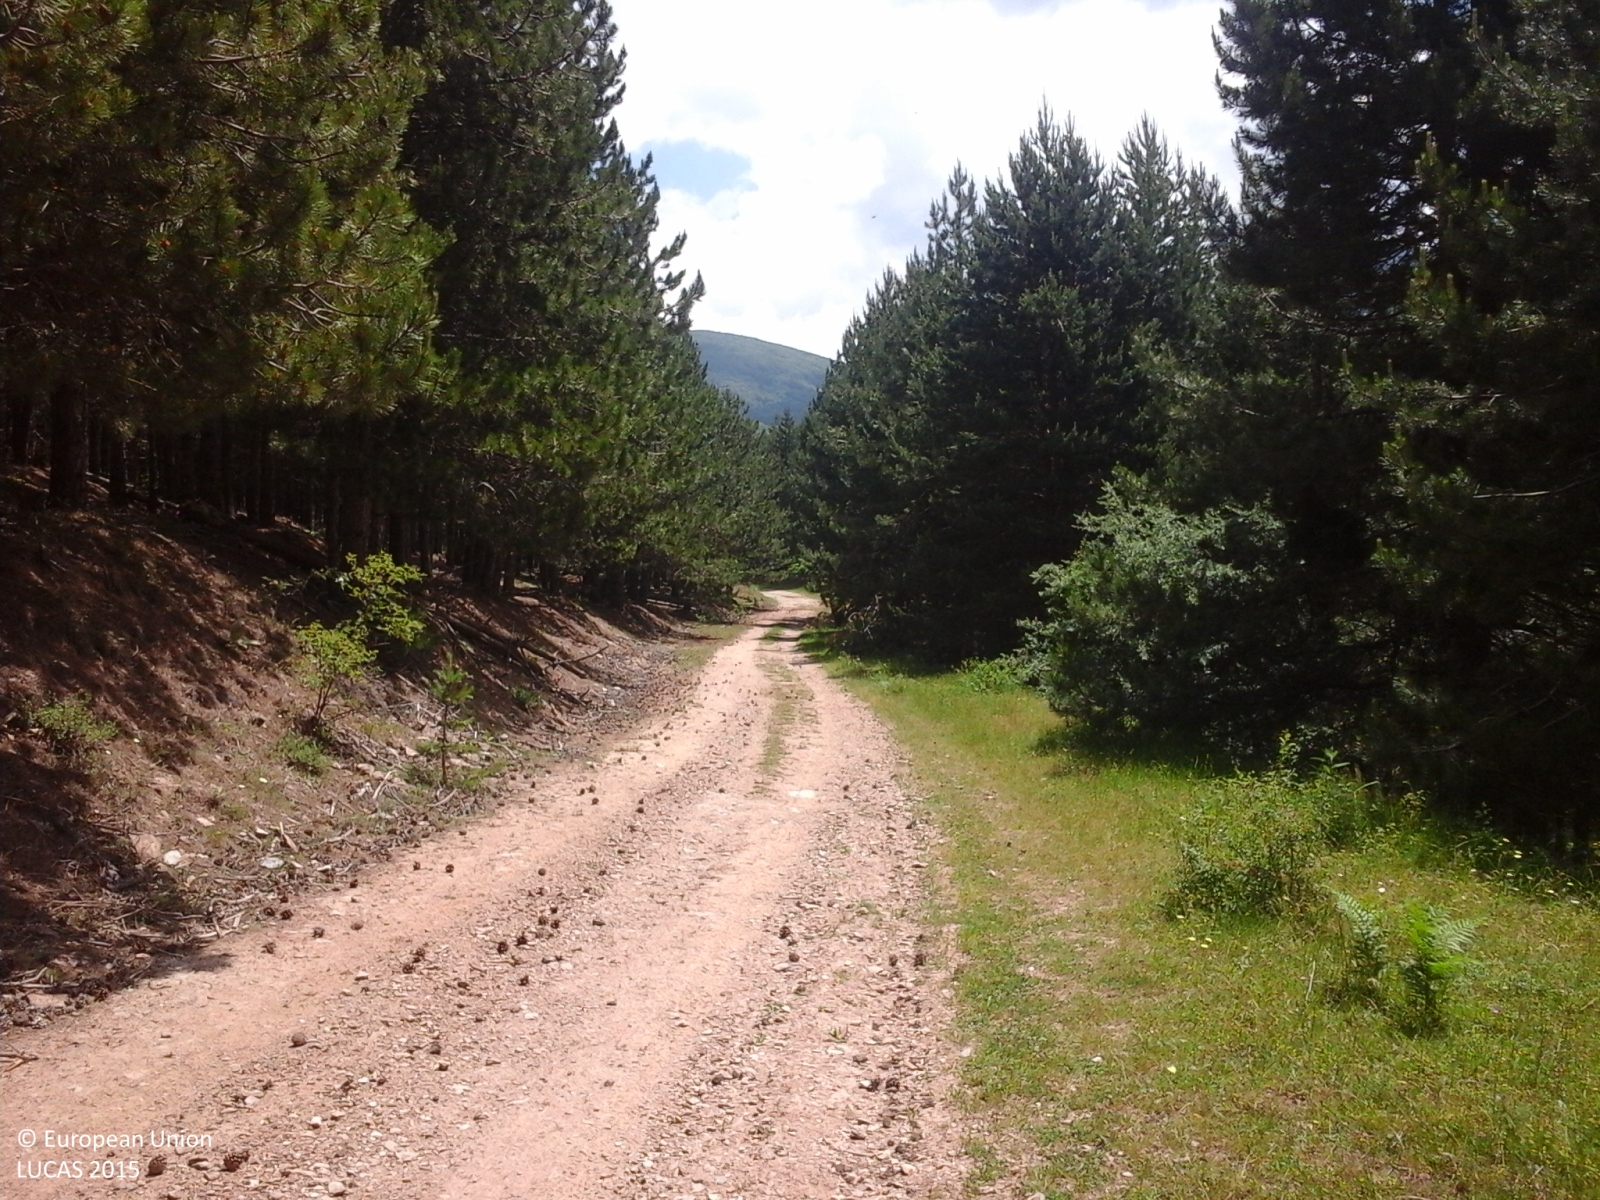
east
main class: Woodland
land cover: Pine dominated coniferous woodland
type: coniferous forest of the mediterranean region
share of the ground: > 75 %
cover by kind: coniferous forest trees 90 %, herbaceous plants 10 %
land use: Forestry
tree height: > 5 m
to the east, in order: Tracks; Pine dominated coniferous woodland; Tracks; Pine dominated coniferous woodland; Grassland with sparse tree/shrub cover; Rocks and stones; Grassland with sparse tree/shrub cover
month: June
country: GR
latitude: 40.6664
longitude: 21.3361
